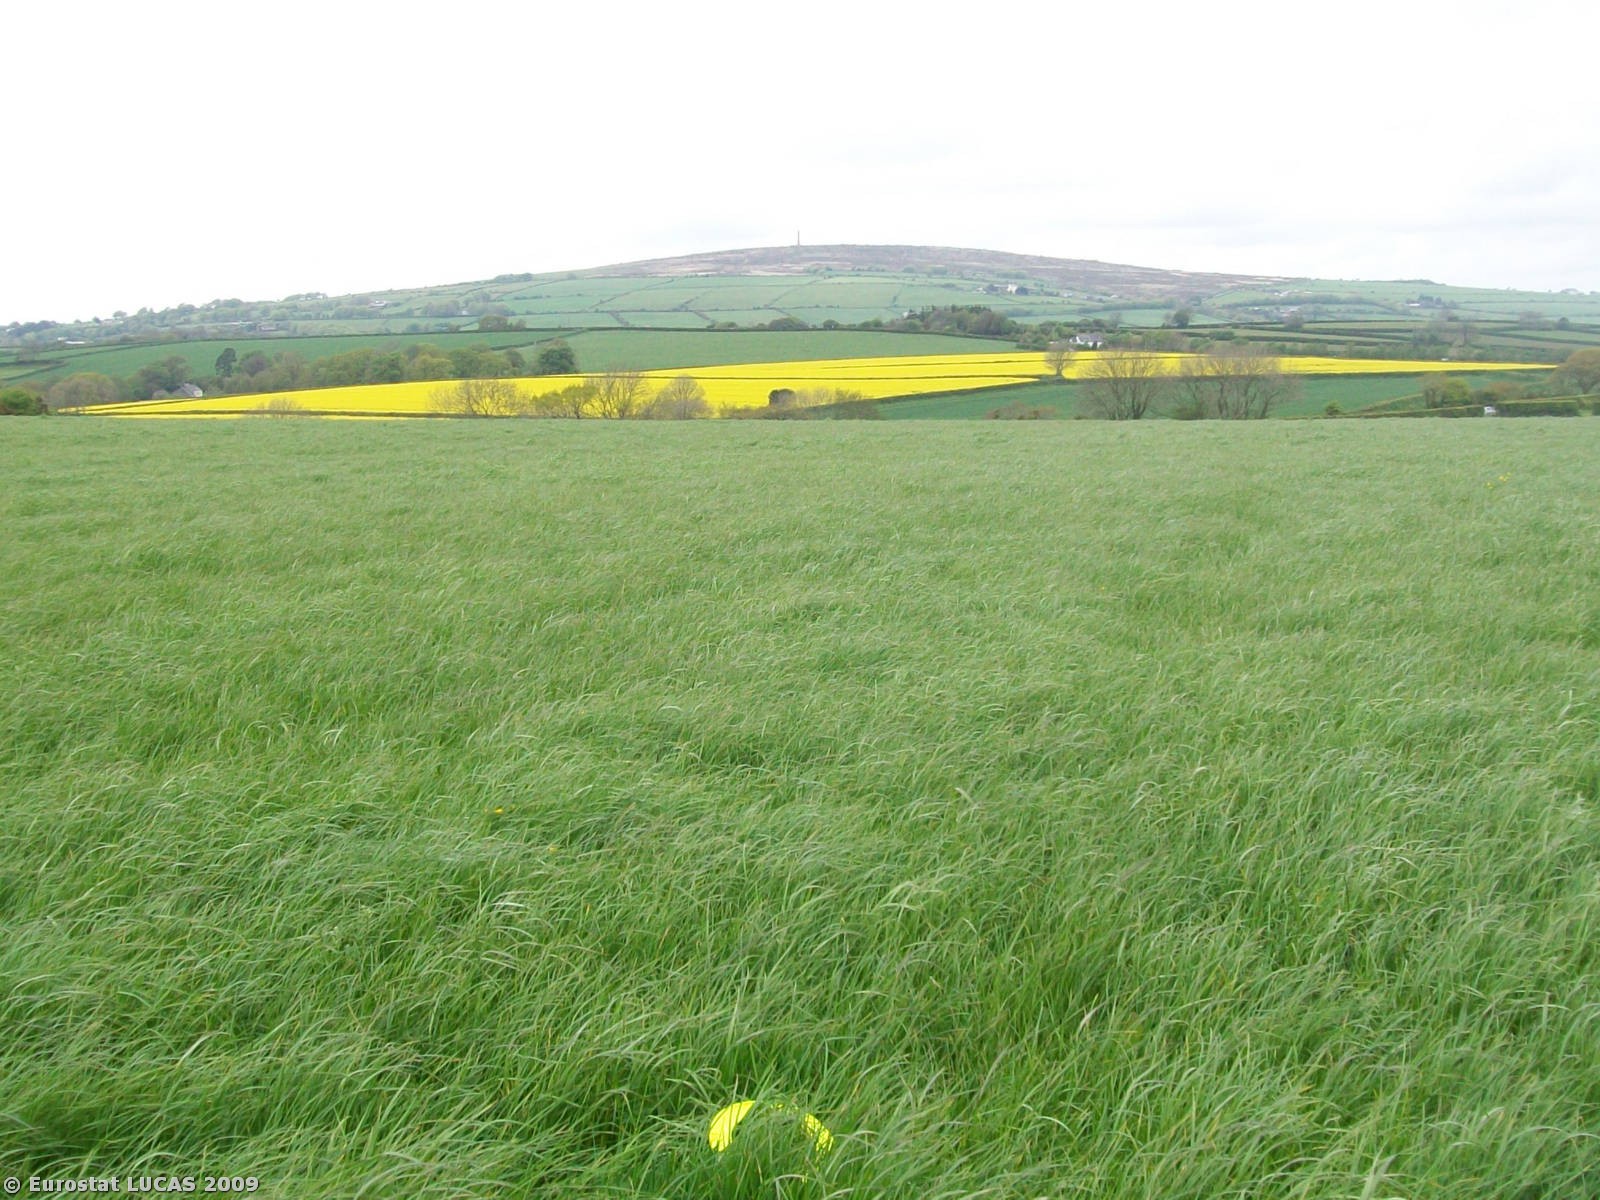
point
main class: Grassland
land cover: Grassland without tree/shrub cover
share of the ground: > 75 %
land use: Agriculture (excluding fallow land and kitchen gardens)
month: May
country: GB
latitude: 50.4835
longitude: -4.2919
